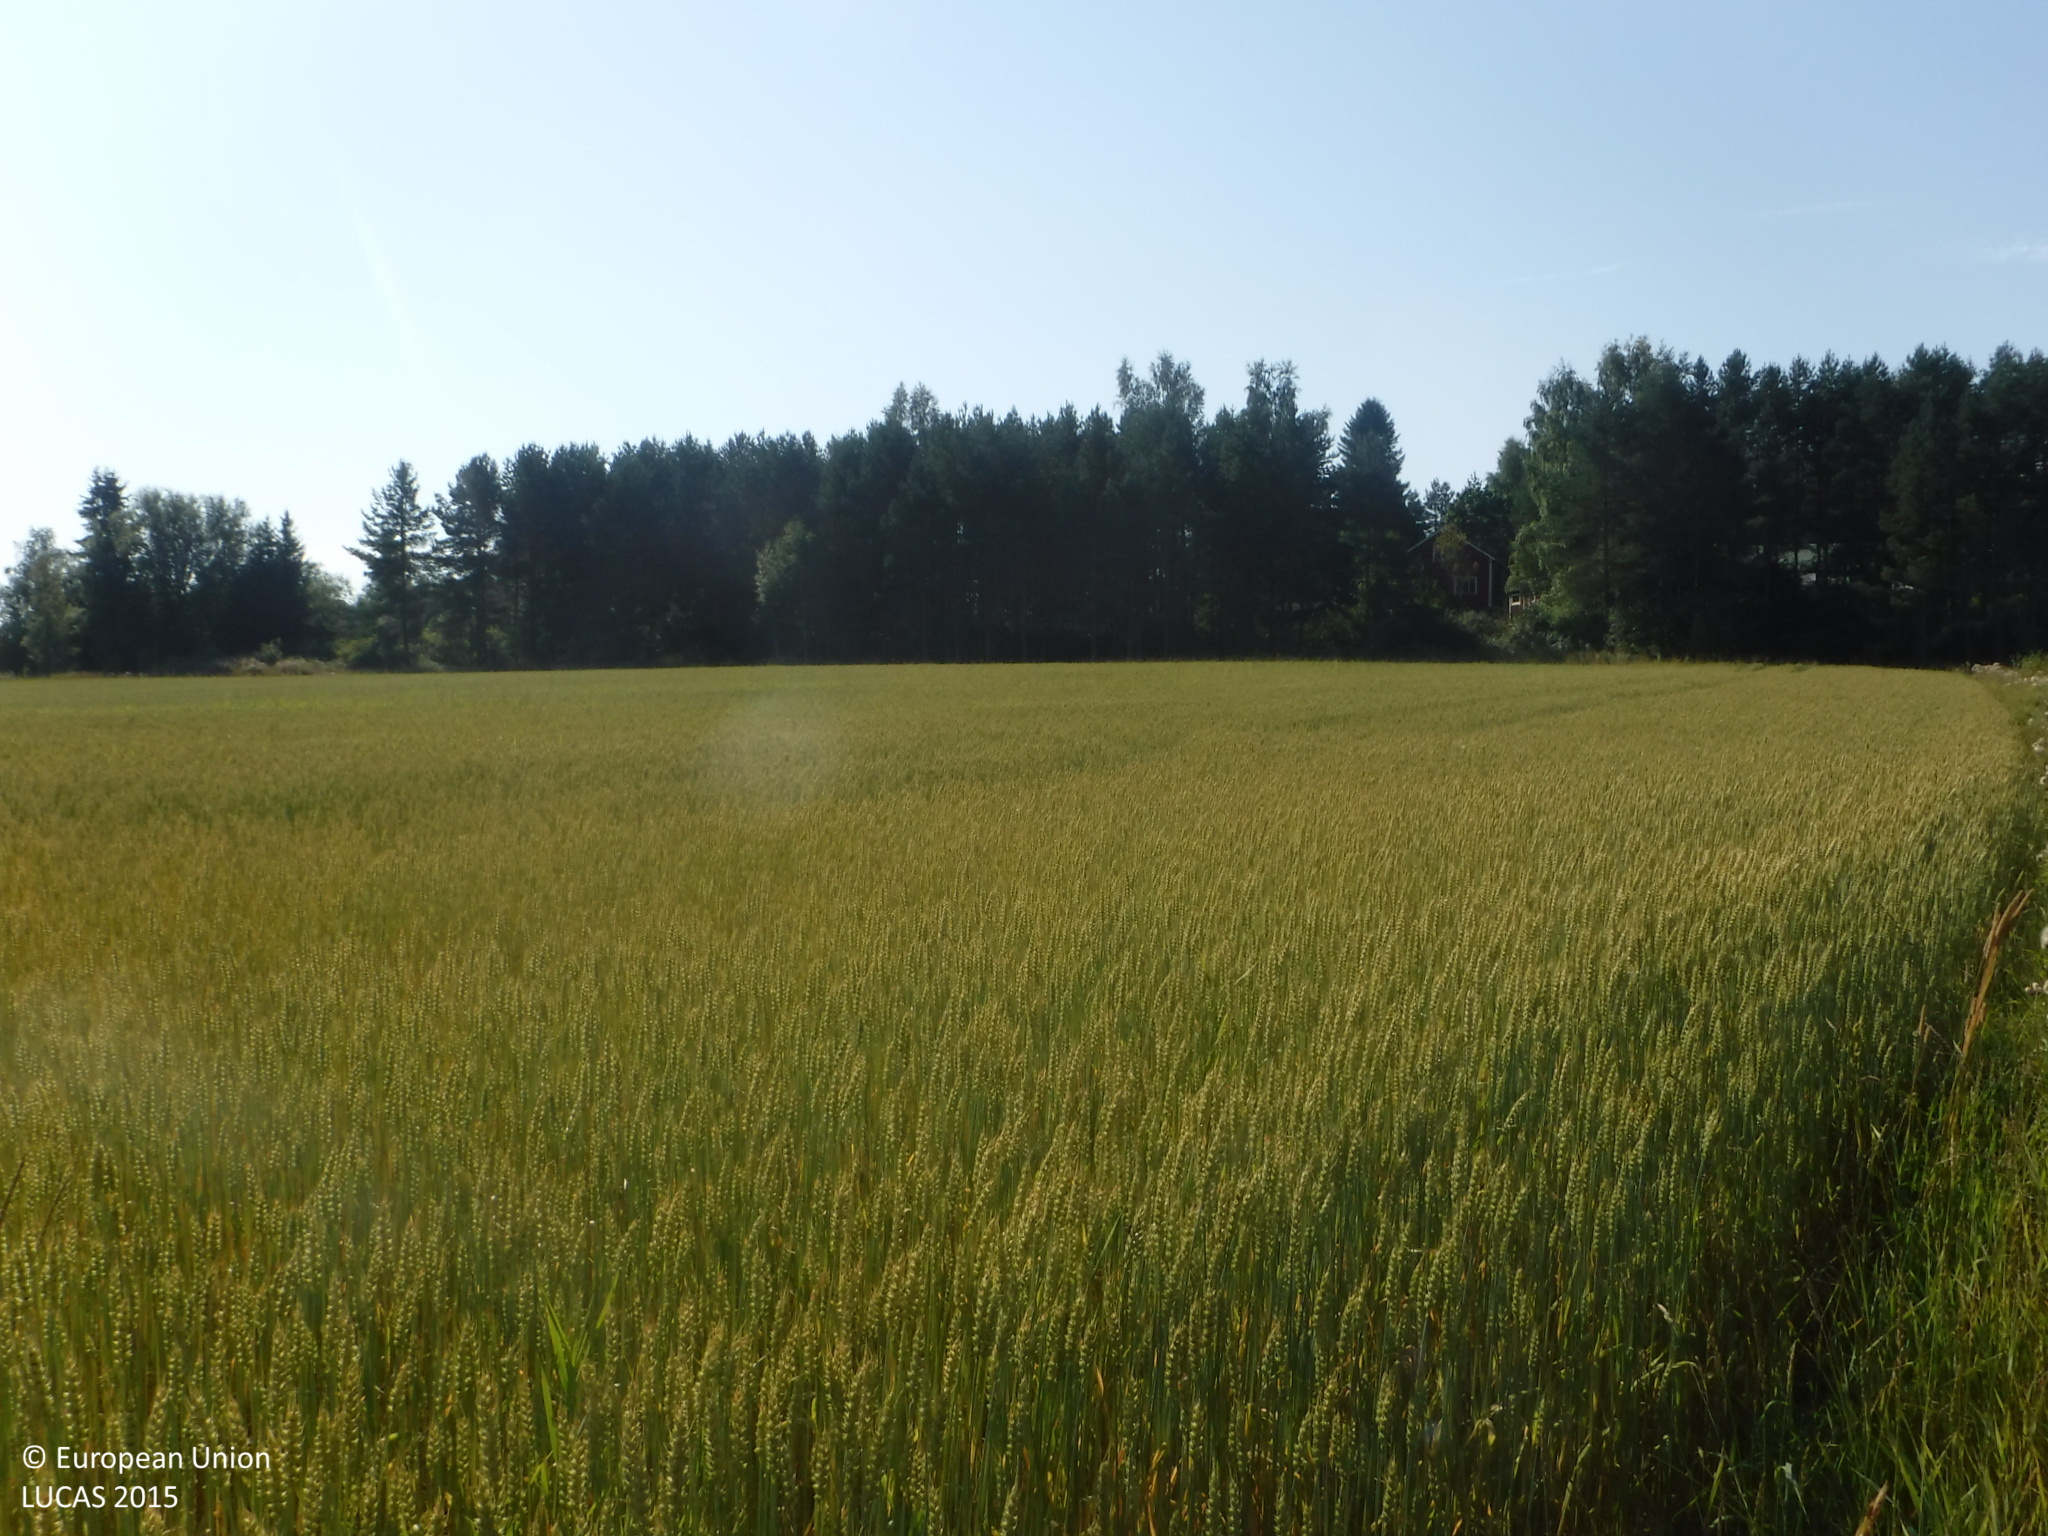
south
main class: Cropland
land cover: Common wheat
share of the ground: > 75 %
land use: Agriculture (excluding fallow land and kitchen gardens)
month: August
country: FI
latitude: 61.1687
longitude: 23.1820
